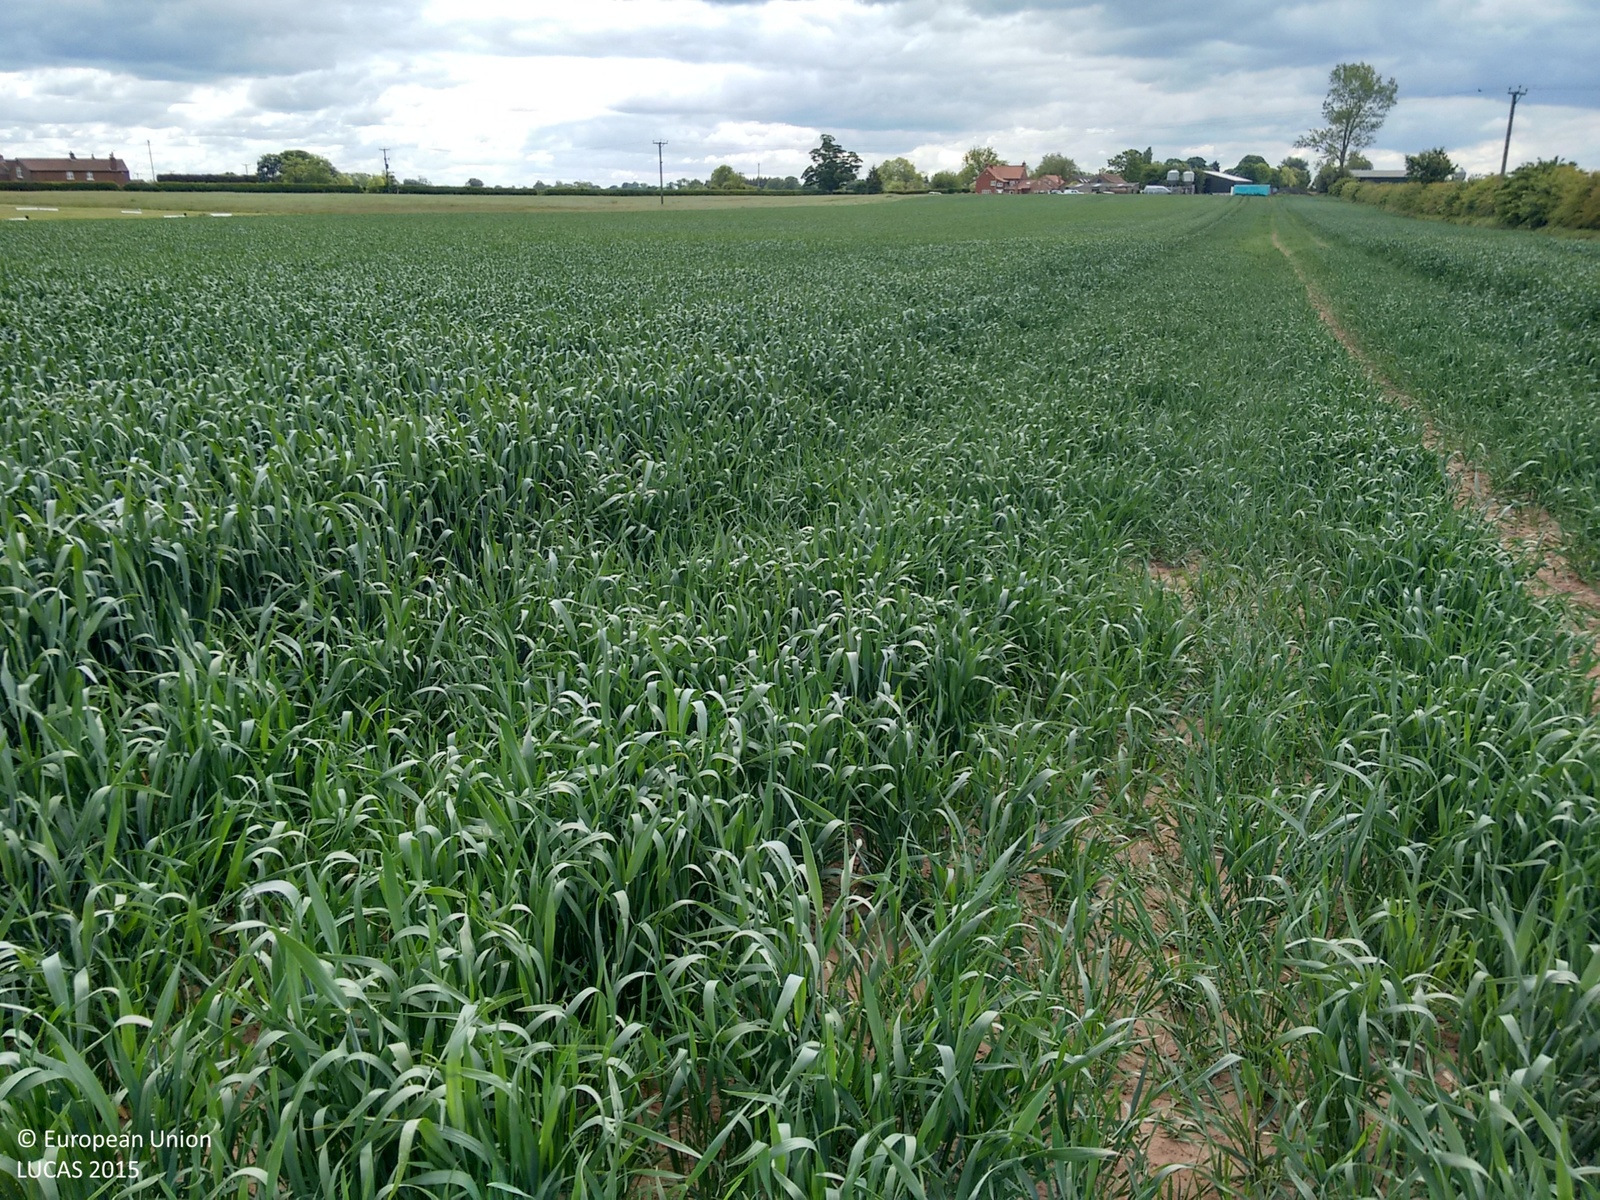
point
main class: Cropland
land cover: Common wheat
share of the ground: > 75 %
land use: Agriculture (excluding fallow land and kitchen gardens)
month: June
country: GB
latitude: 54.2405
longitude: -1.4179
